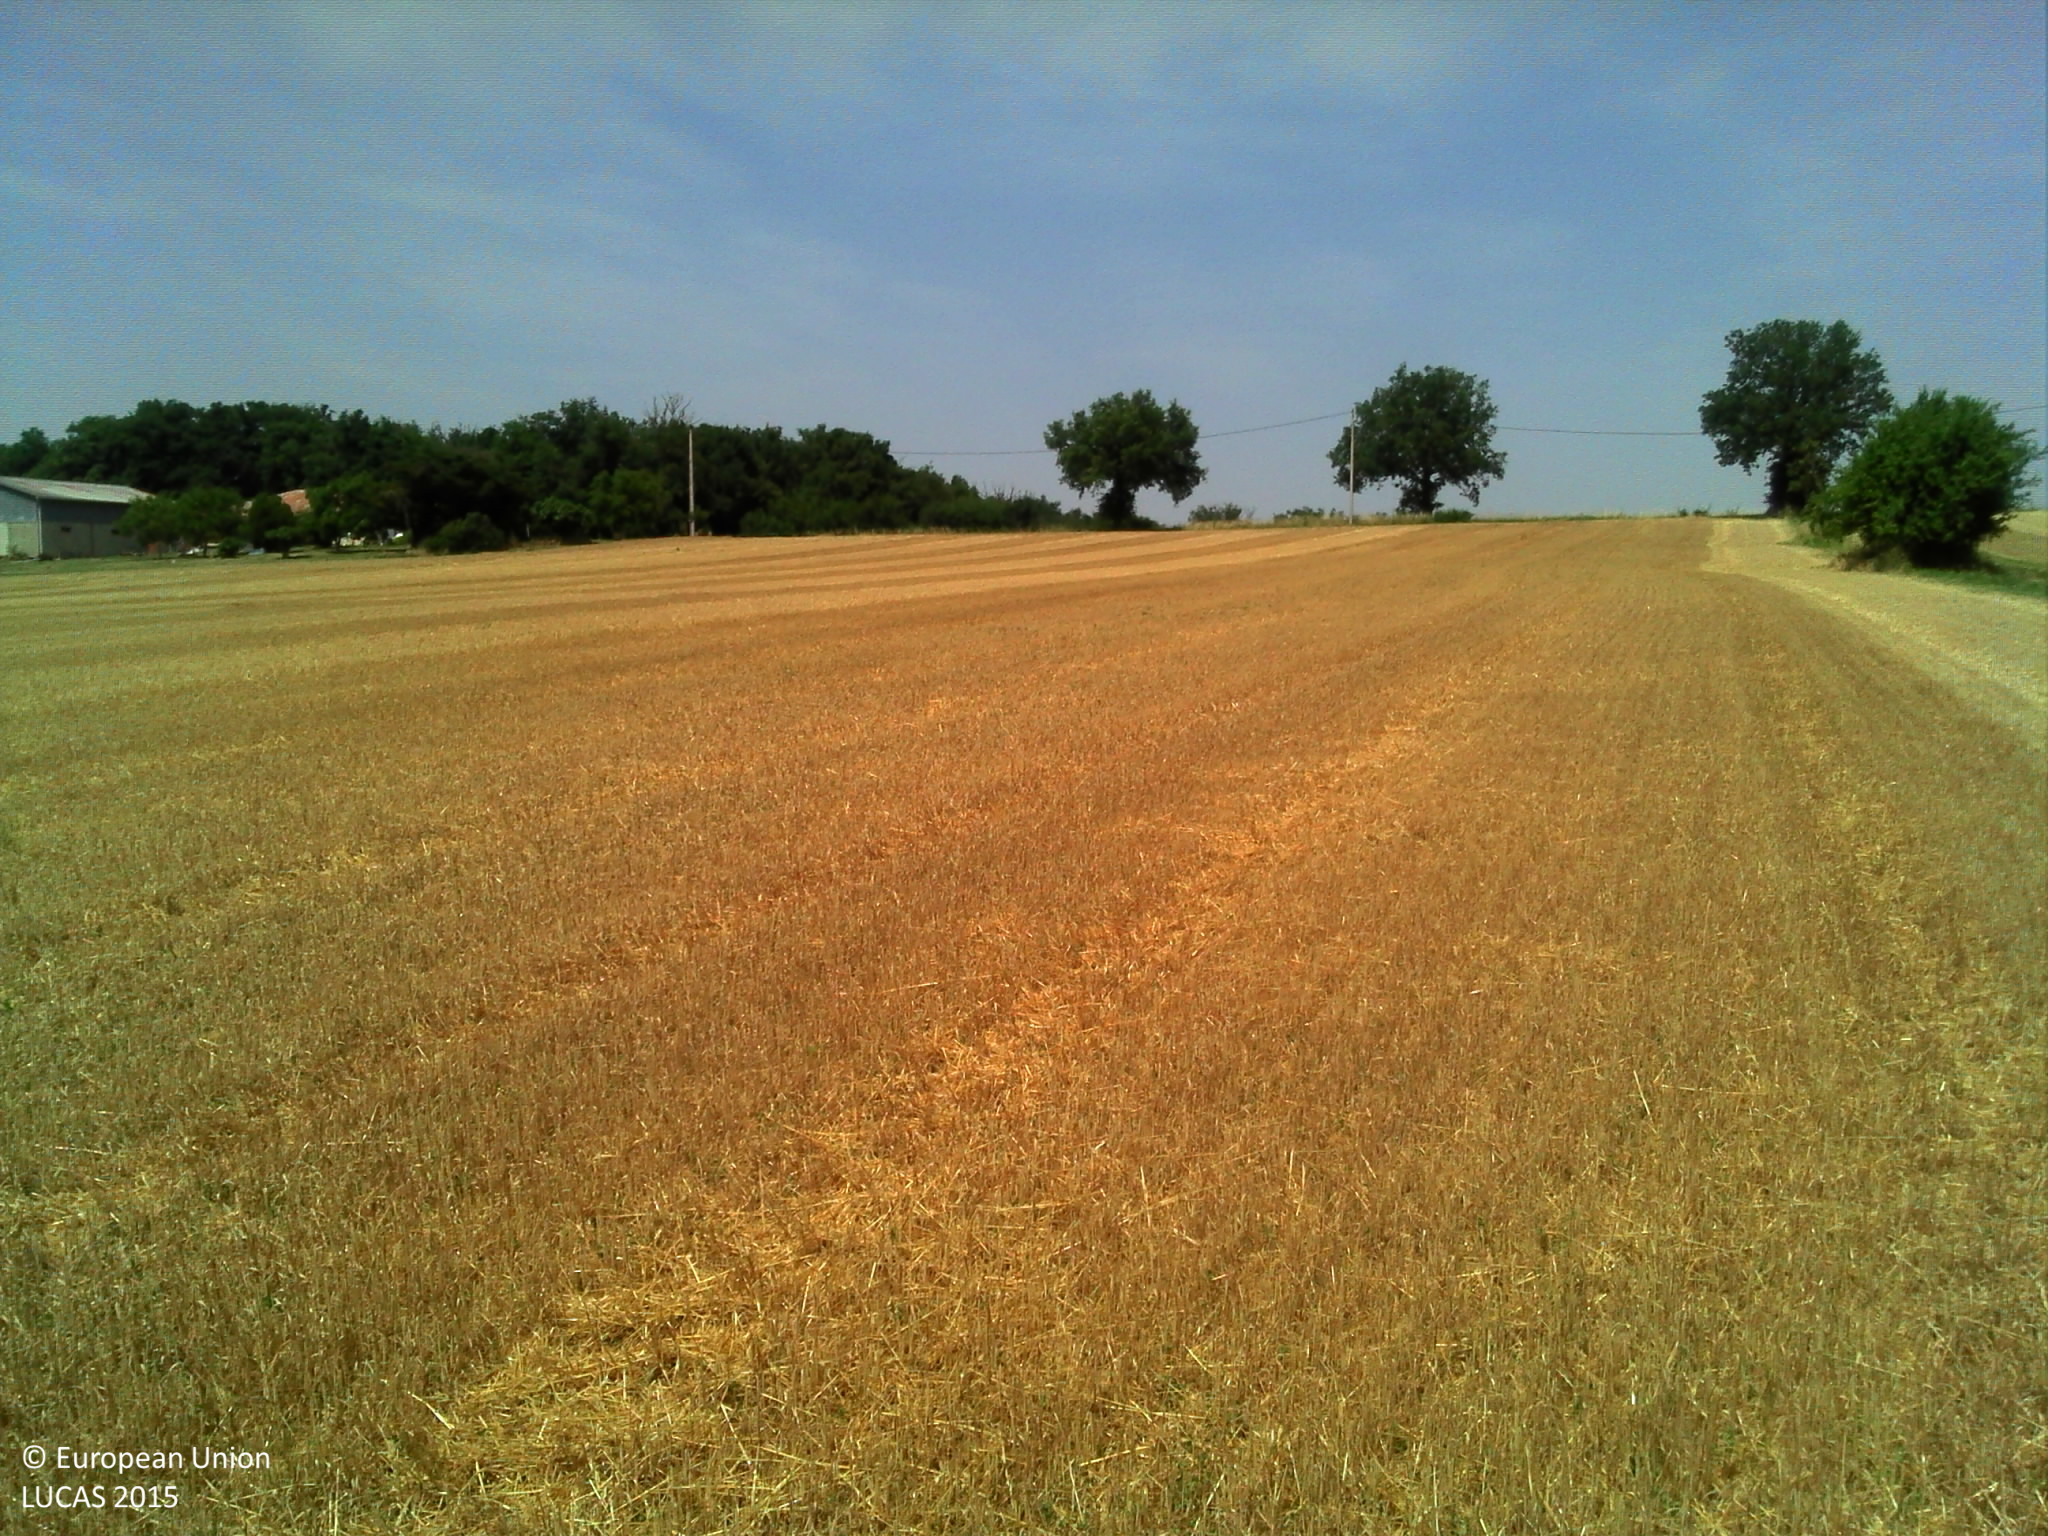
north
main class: Cropland
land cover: Barley
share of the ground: > 75 %
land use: Agriculture (excluding fallow land and kitchen gardens)
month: July
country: FR
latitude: 43.6492
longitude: 0.9866
